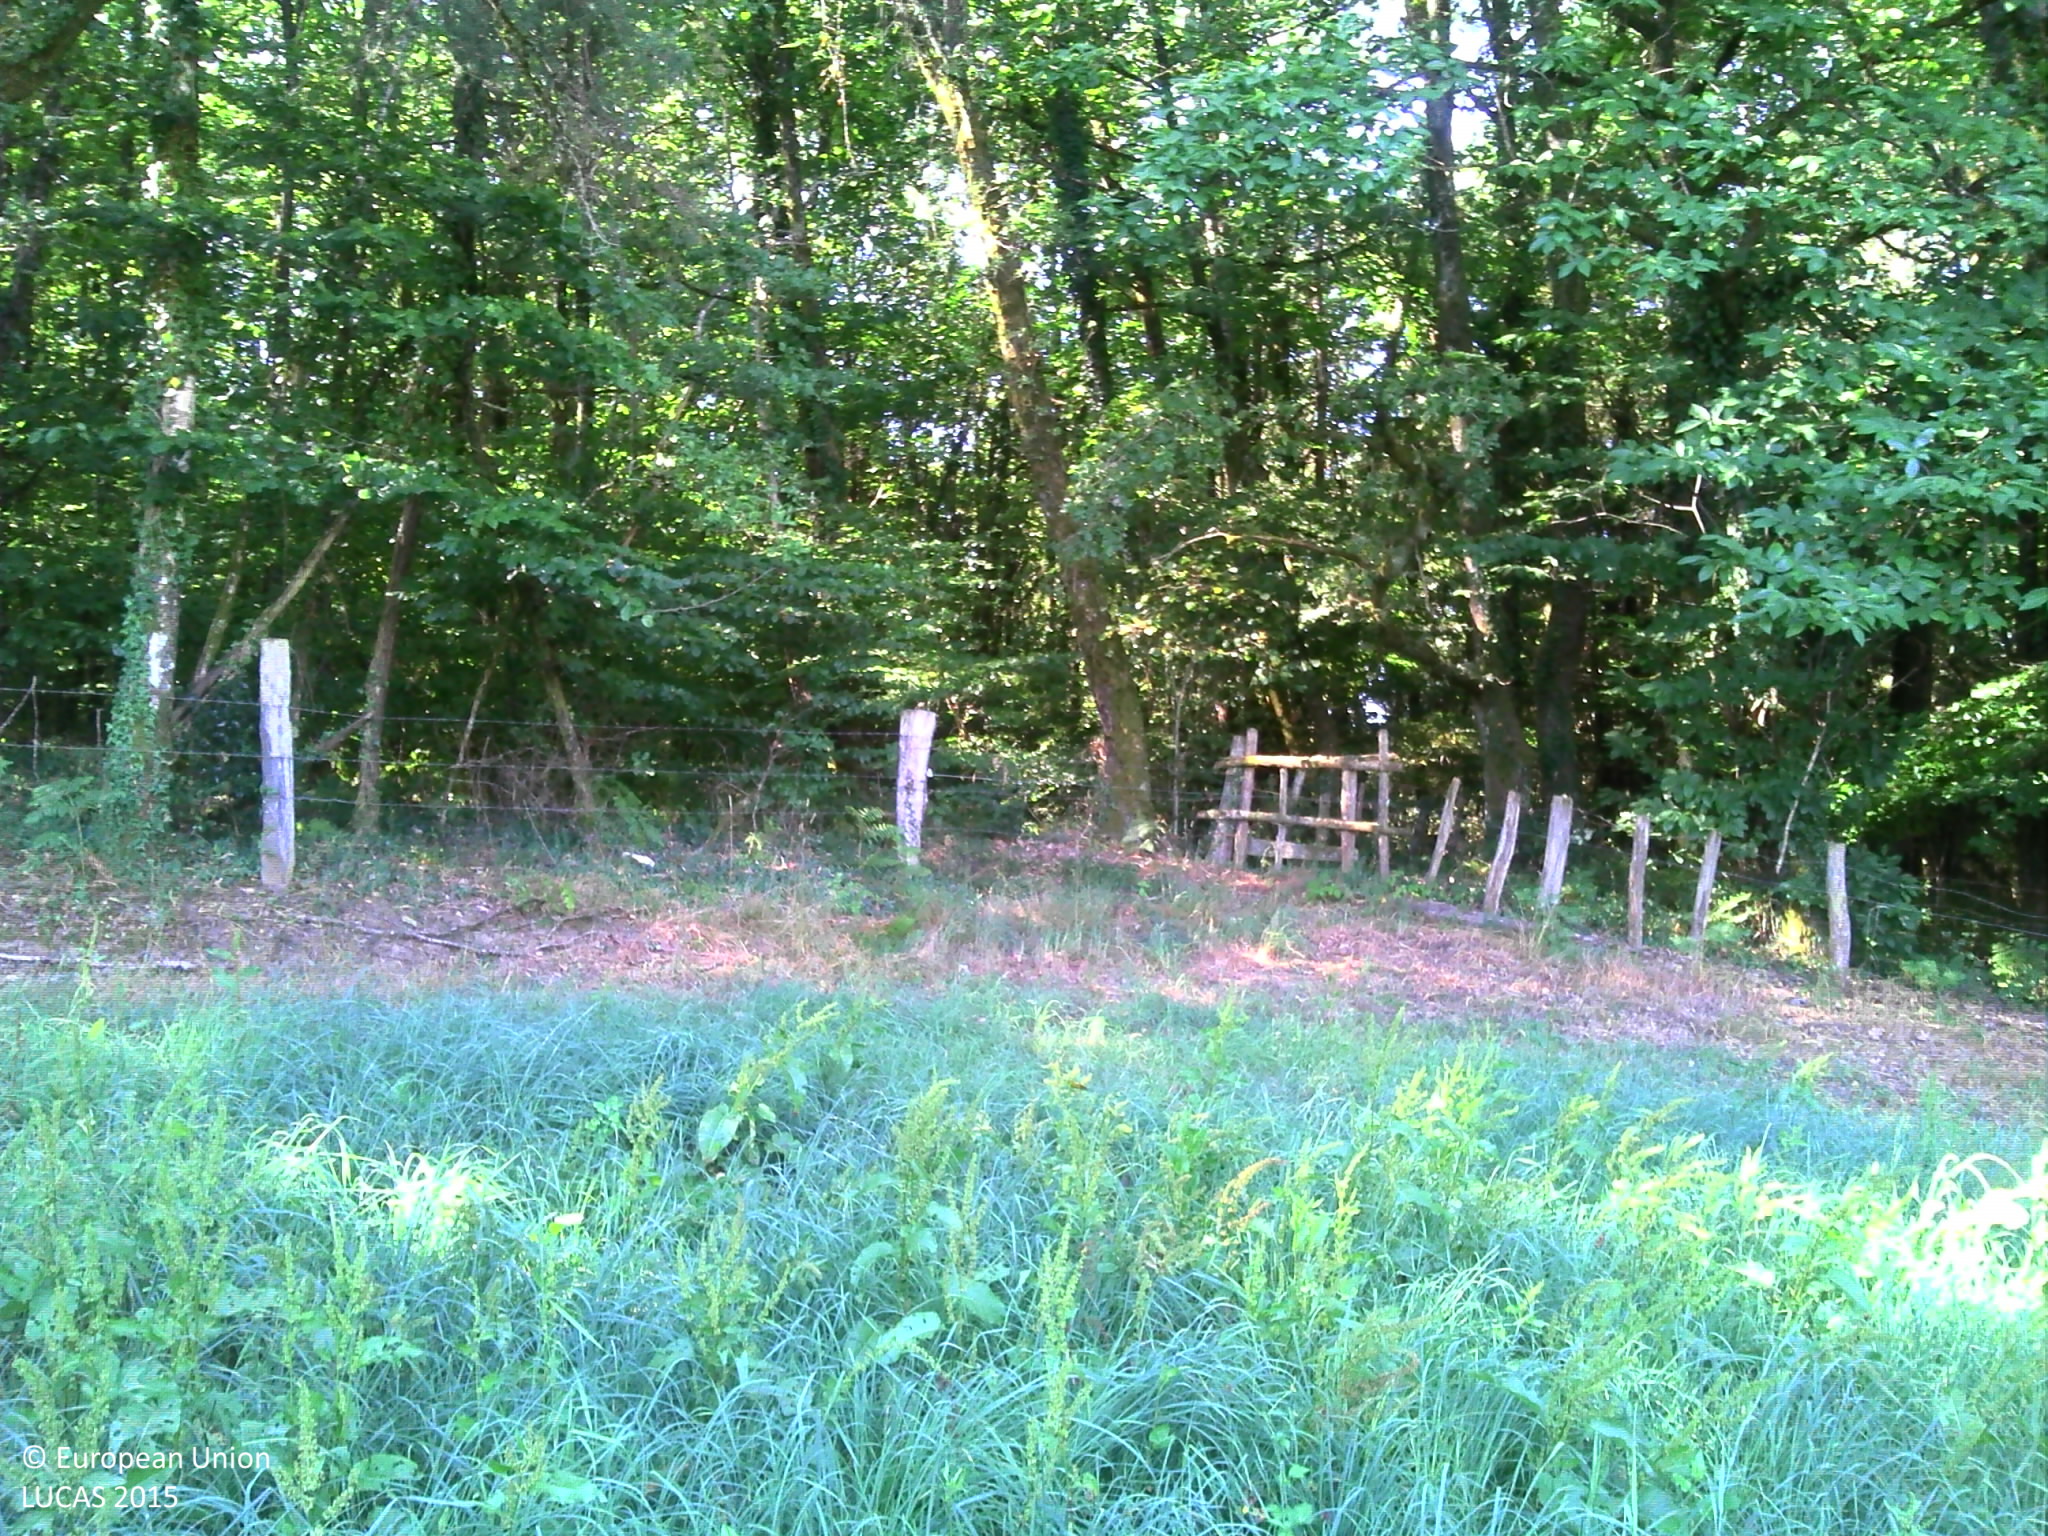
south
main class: Grassland
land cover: Grassland without tree/shrub cover
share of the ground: > 75 %
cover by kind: herbaceous plants 100 %
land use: Agriculture (excluding fallow land and kitchen gardens)
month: July
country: FR
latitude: 45.5360
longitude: 1.6578
